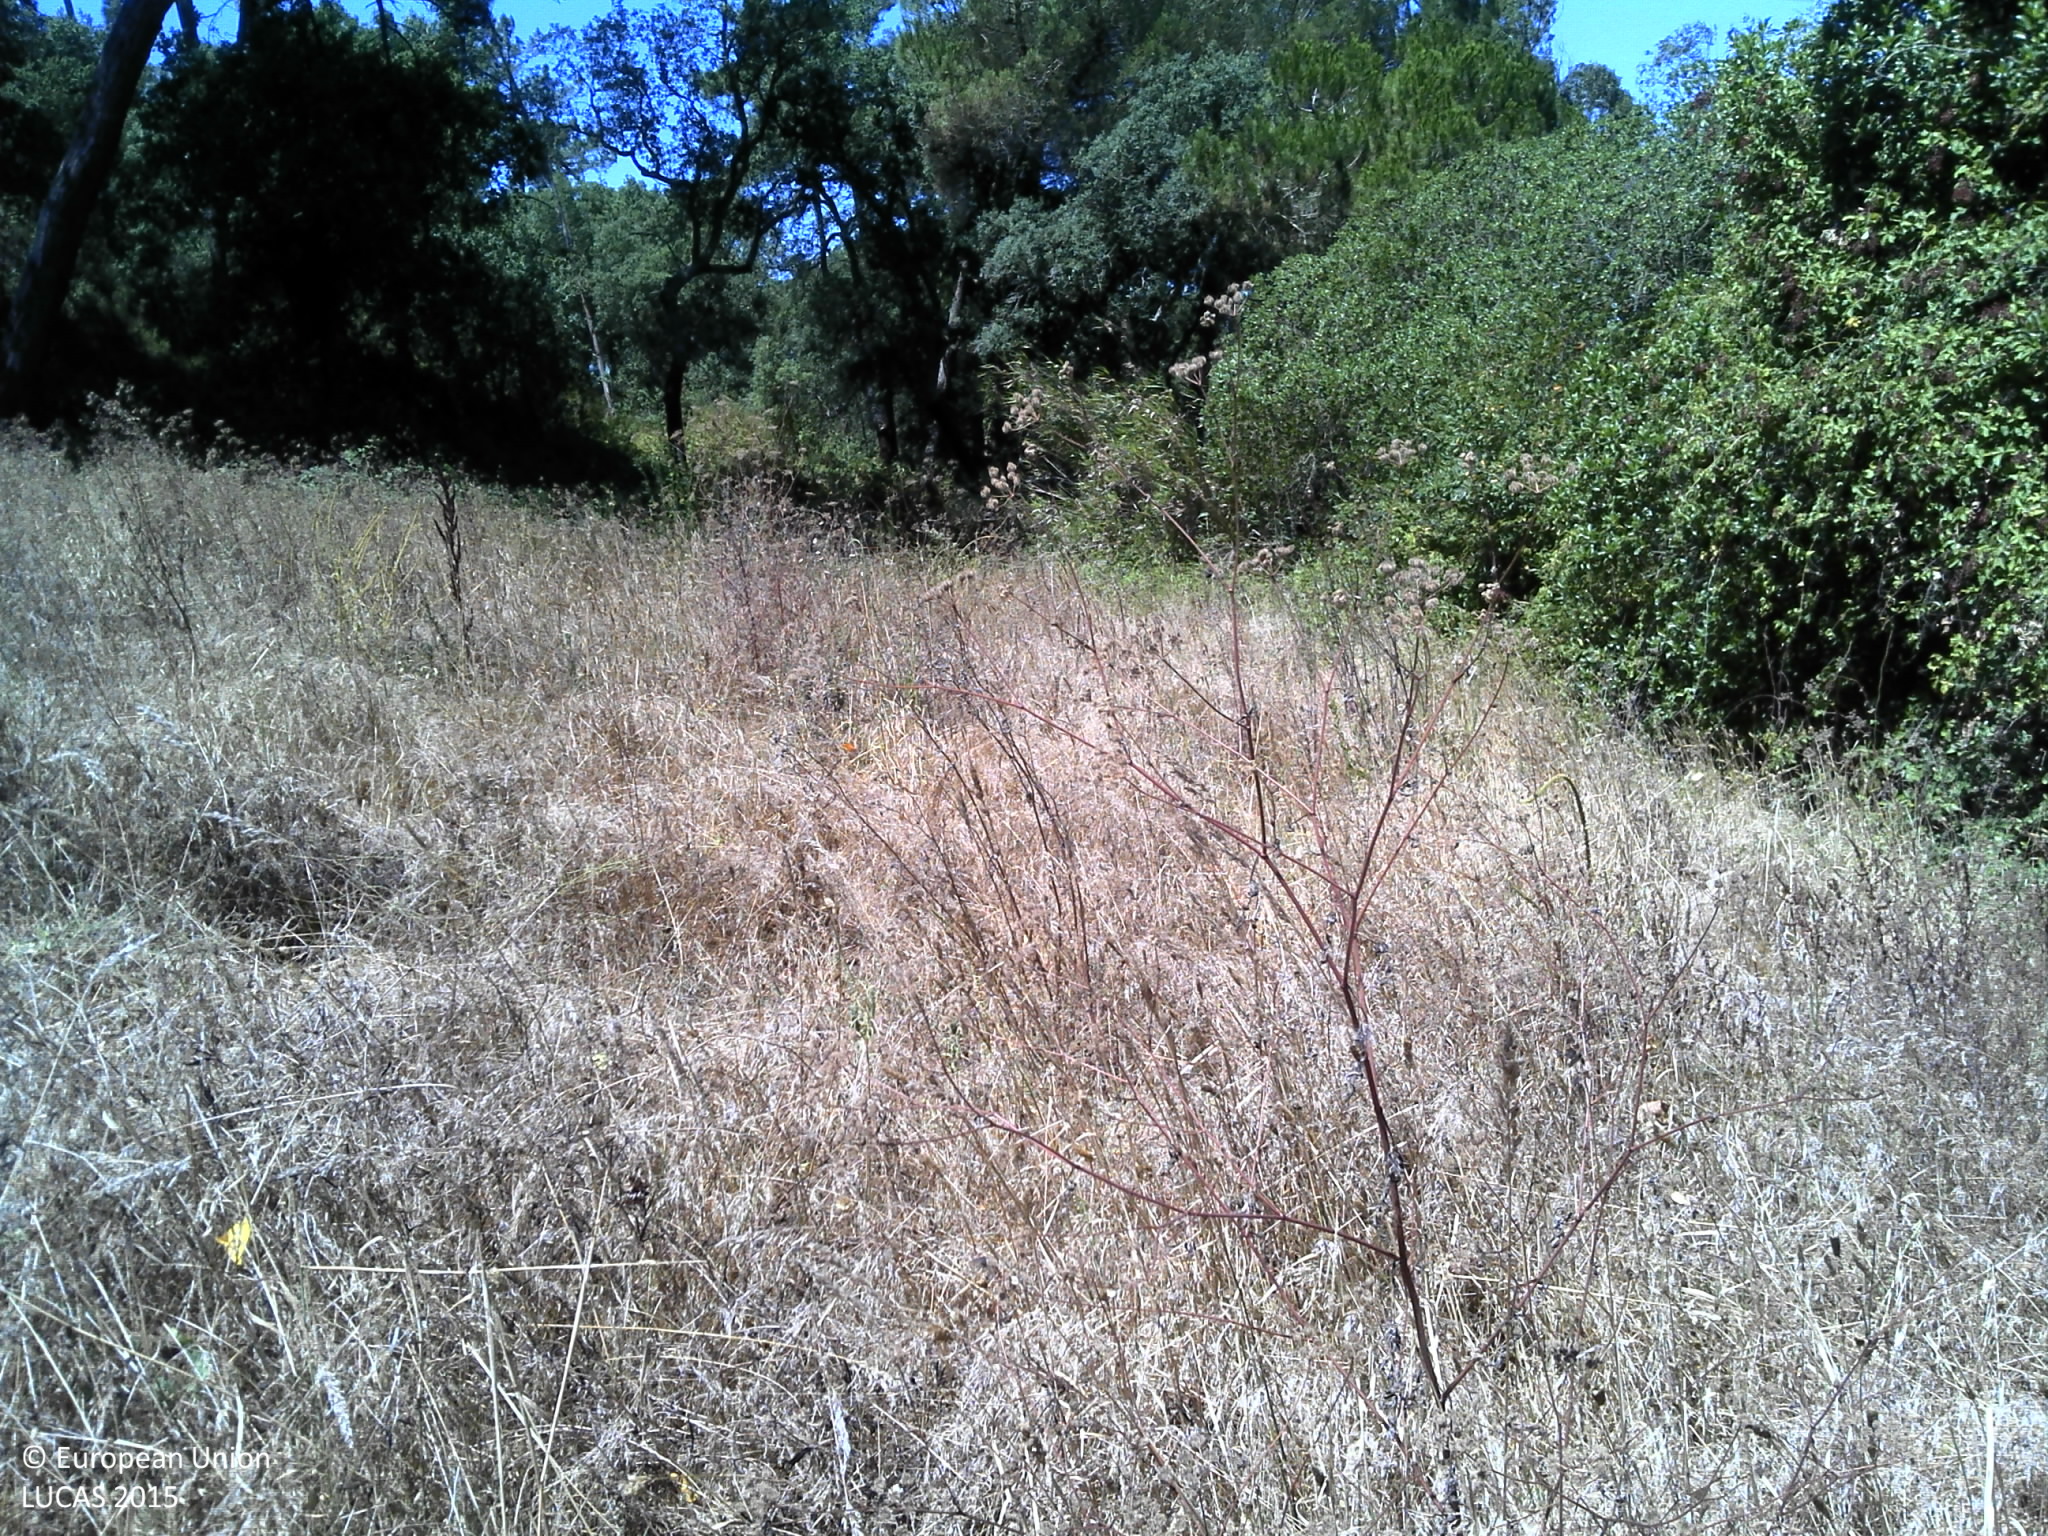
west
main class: Grassland
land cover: Grassland without tree/shrub cover
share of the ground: 50 - 75 %
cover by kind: herbaceous plants 70 %, unconsolidated bare surface 5 %
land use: Agriculture (excluding fallow land and kitchen gardens)
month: July
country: PT
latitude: 38.9395
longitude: -9.2217
